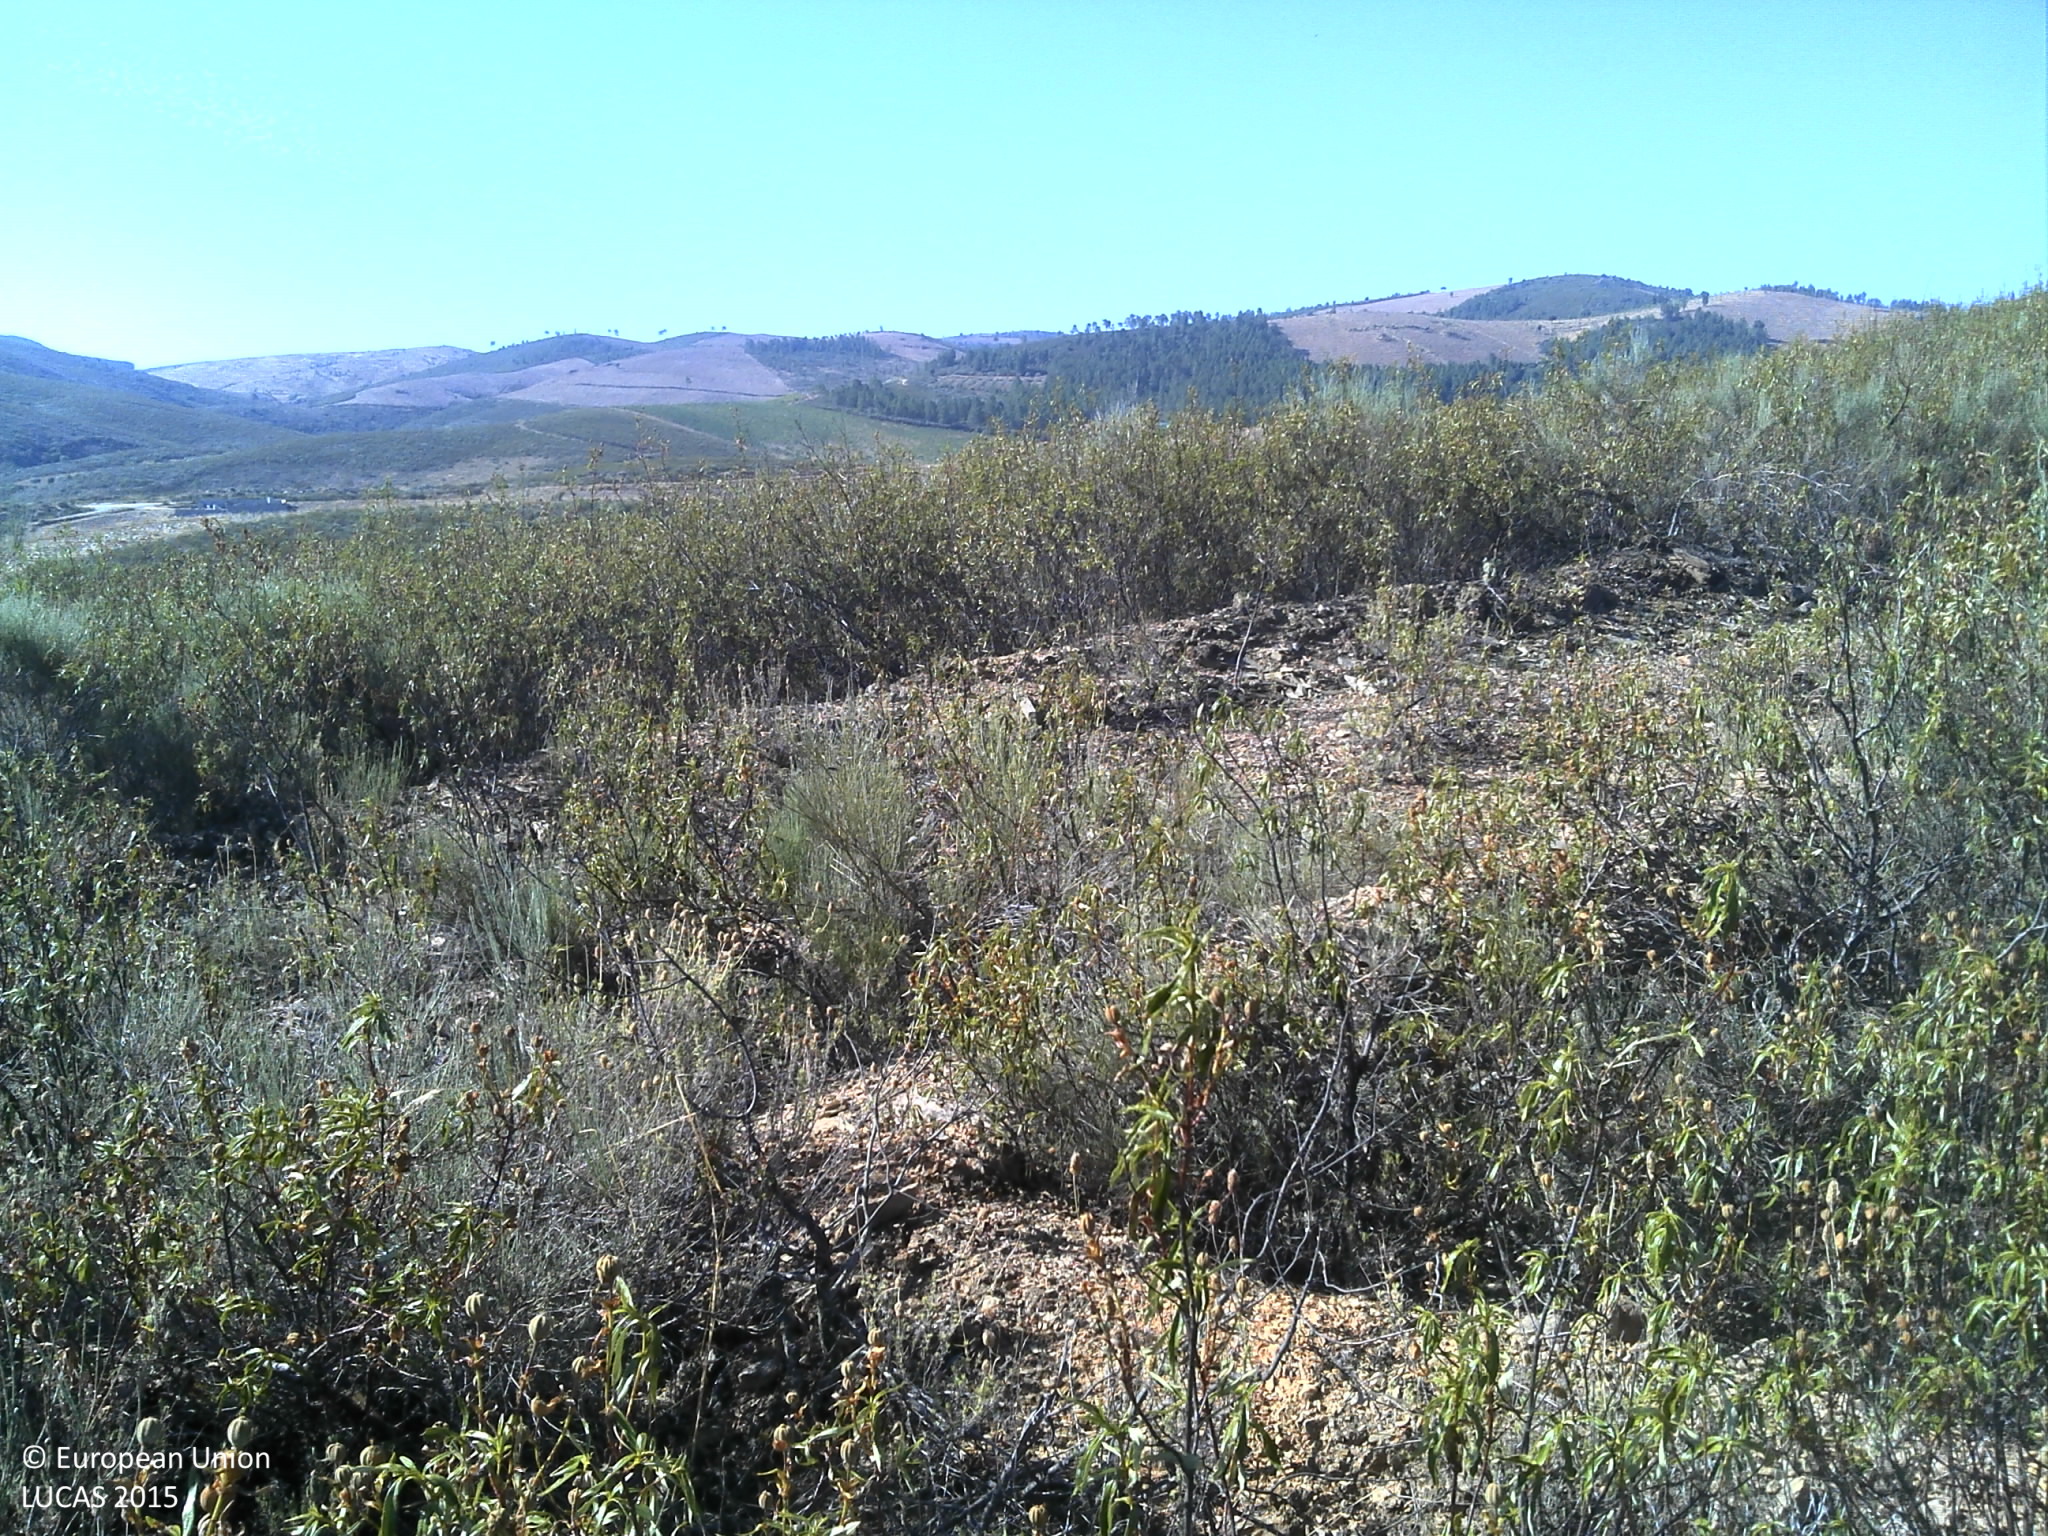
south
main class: Shrubland
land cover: Shrubland with sparse tree cover
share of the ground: > 75 %
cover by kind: shrubs 95 %, coniferous forest trees 5 %
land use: Abandoned areas
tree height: < 5 m
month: July
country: PT
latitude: 41.0936
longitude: -7.0021
